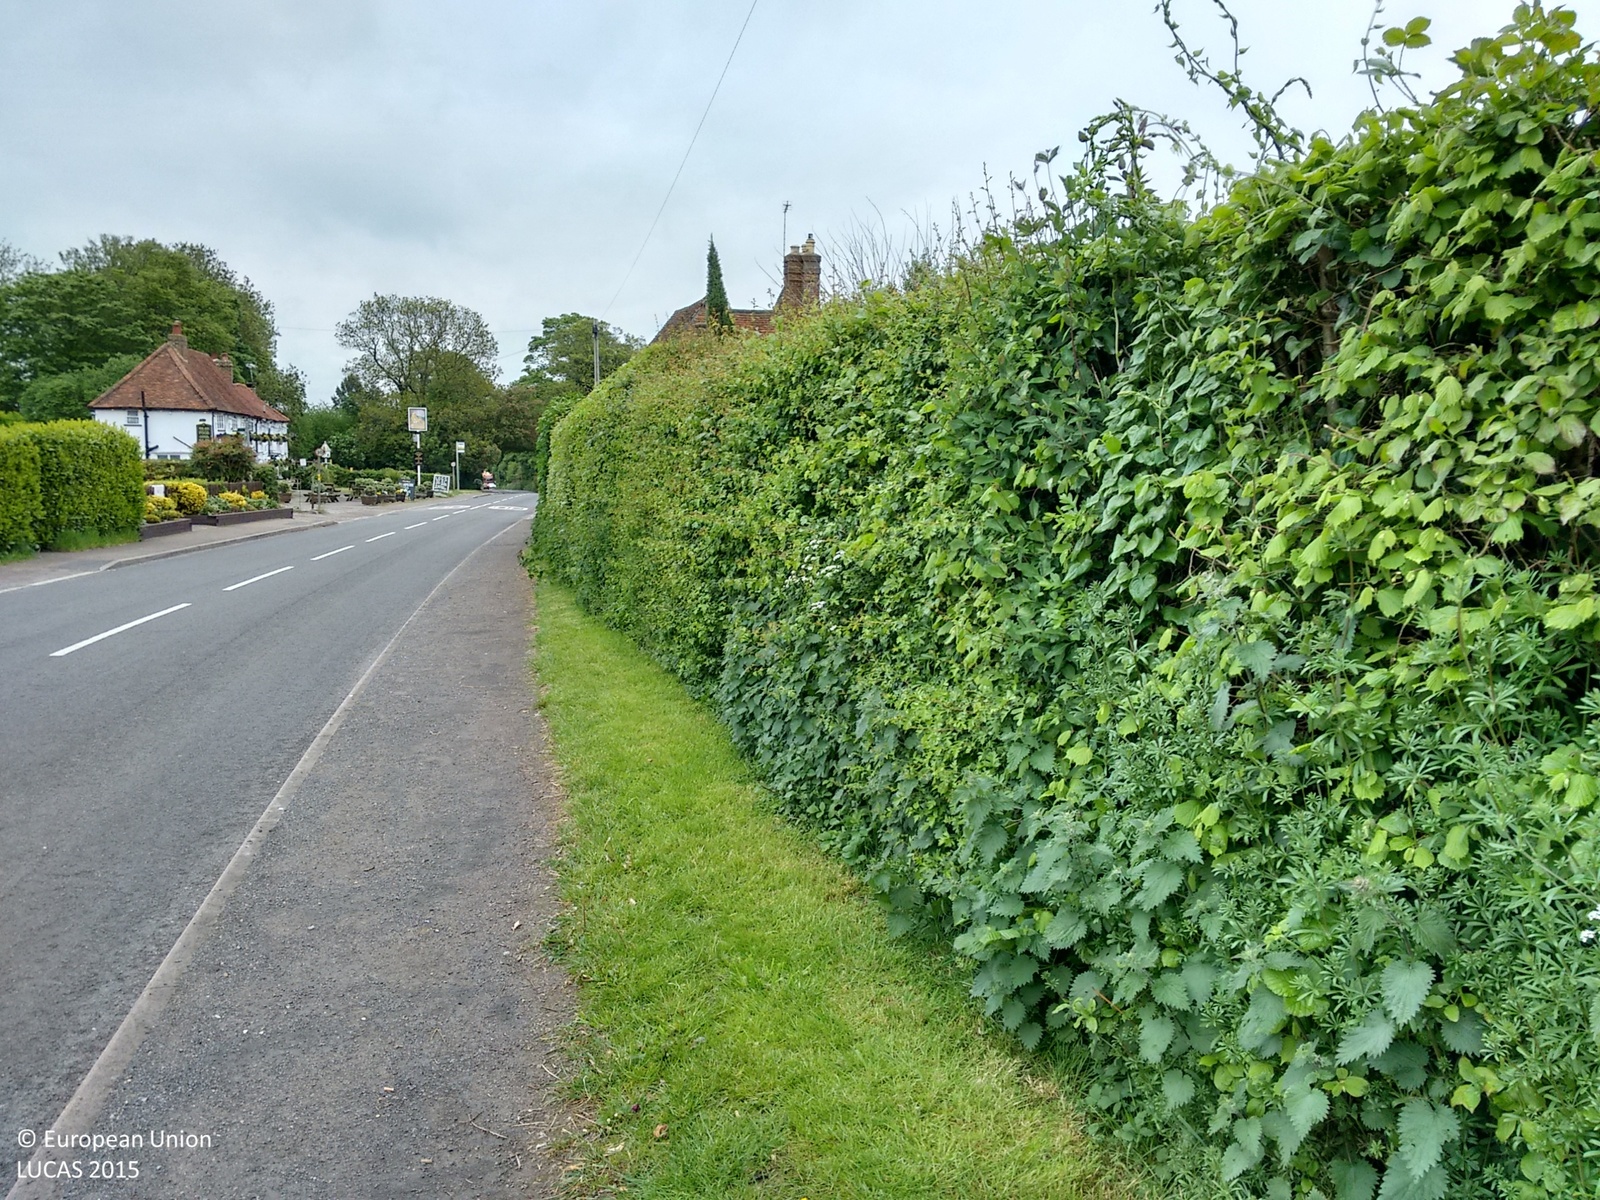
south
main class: Grassland
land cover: Grassland without tree/shrub cover
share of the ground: > 75 %
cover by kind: herbaceous plants 100 %
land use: Agriculture (excluding fallow land and kitchen gardens)
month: May
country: GB
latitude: 51.7108
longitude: -0.5020
